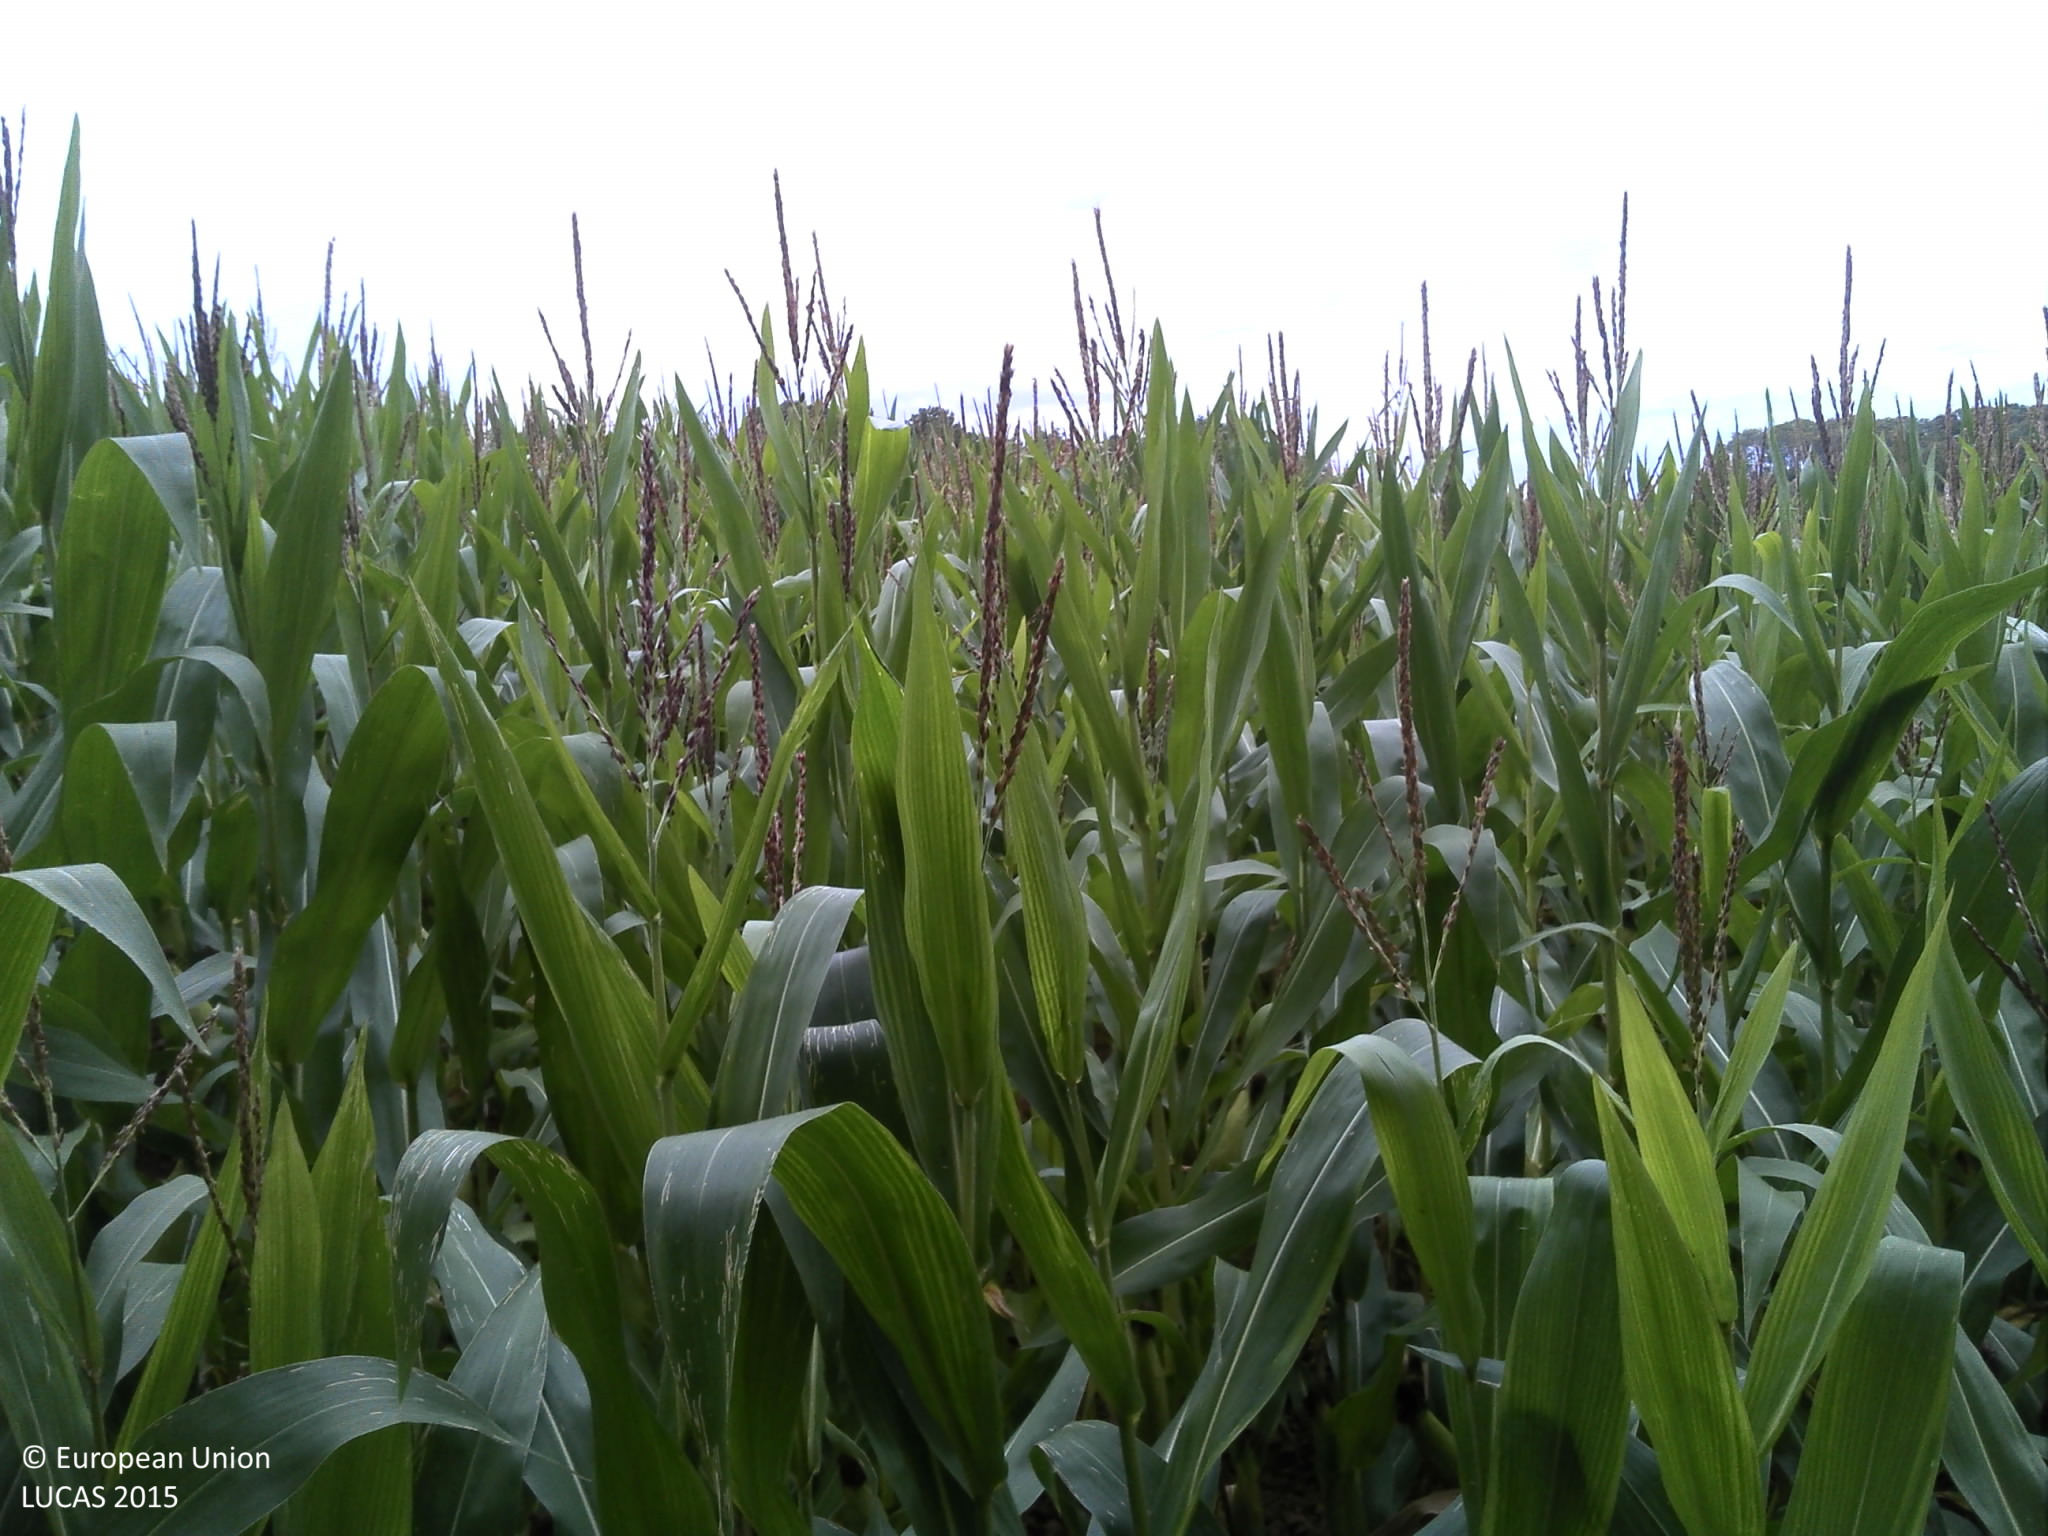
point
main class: Cropland
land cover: Maize
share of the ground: > 75 %
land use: Agriculture (excluding fallow land and kitchen gardens)
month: July
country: FR
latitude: 49.5830
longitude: 4.1444
